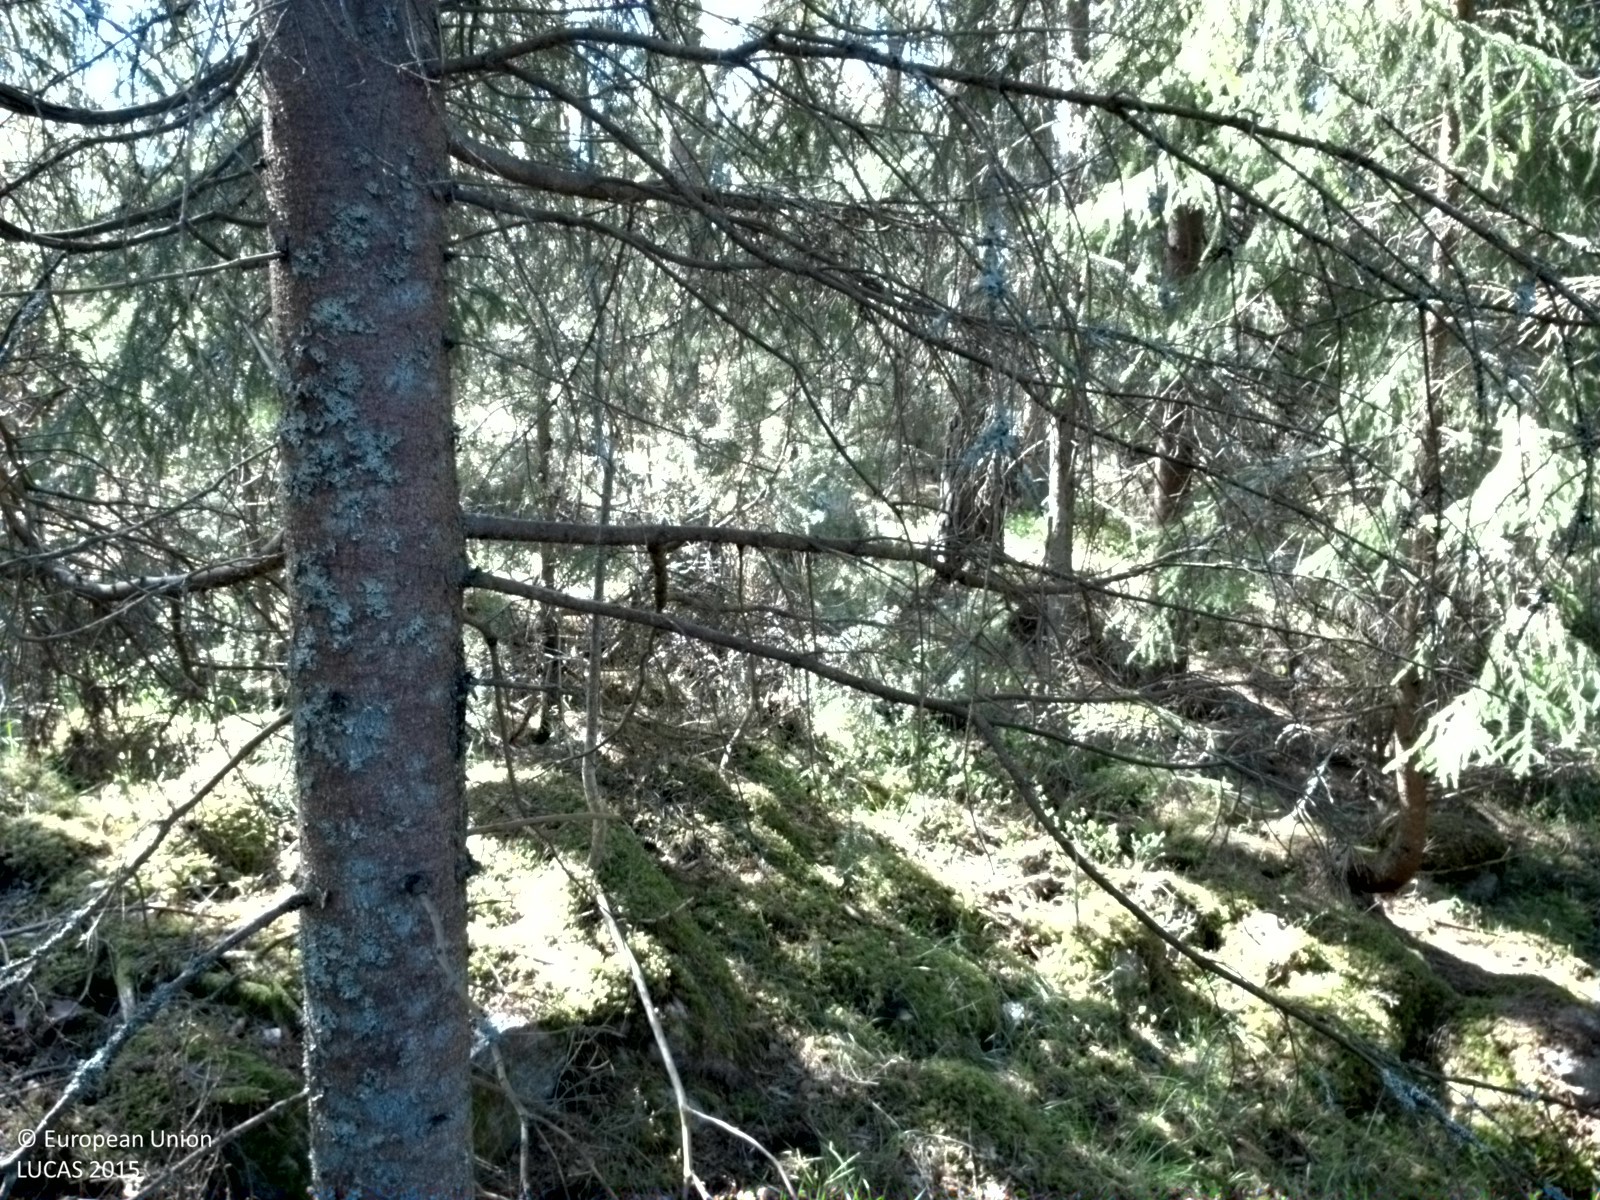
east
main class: Woodland
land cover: Spruce dominated coniferous woodland
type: boreal forest
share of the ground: > 75 %
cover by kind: coniferous forest trees 75 %, lichens and mosses 10 %, herbaceous plants 5 %, consolidated bare surface 5 %
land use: Forestry
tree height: > 5 m
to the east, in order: Spruce dominated coniferous woodland; Fences; Pine dominated coniferous woodland; Tracks; Grassland with sparse tree/shrub cover; Grassland without tree/shrub cover; Fences; Ditches and canals; Other bare soil; Grass margins; Ditches and canals; Fences; Grassland without tree/shrub cover
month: May
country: SE
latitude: 60.1361
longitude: 17.9702
